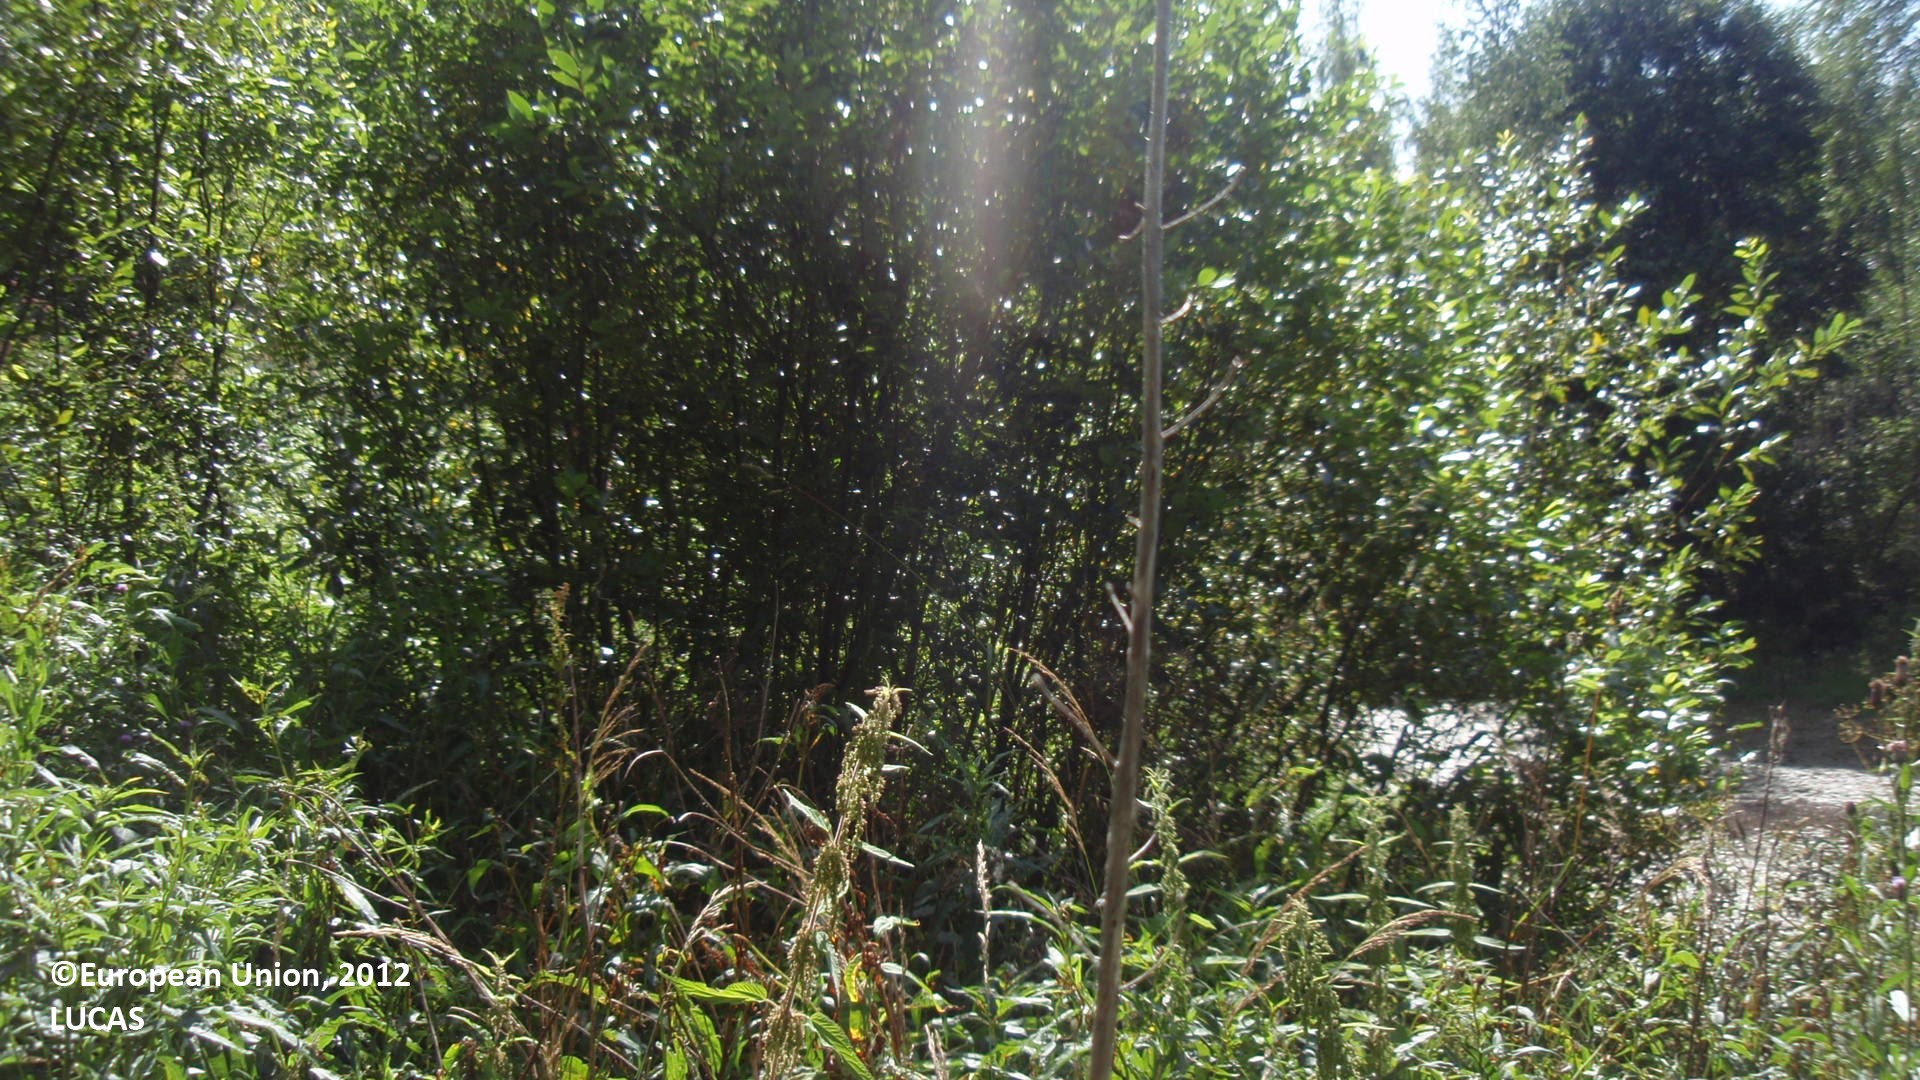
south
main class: Shrubland
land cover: Shrubland with sparse tree cover
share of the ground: > 75 %
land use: Forestry
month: August
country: FI
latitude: 61.0689
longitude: 28.6988
